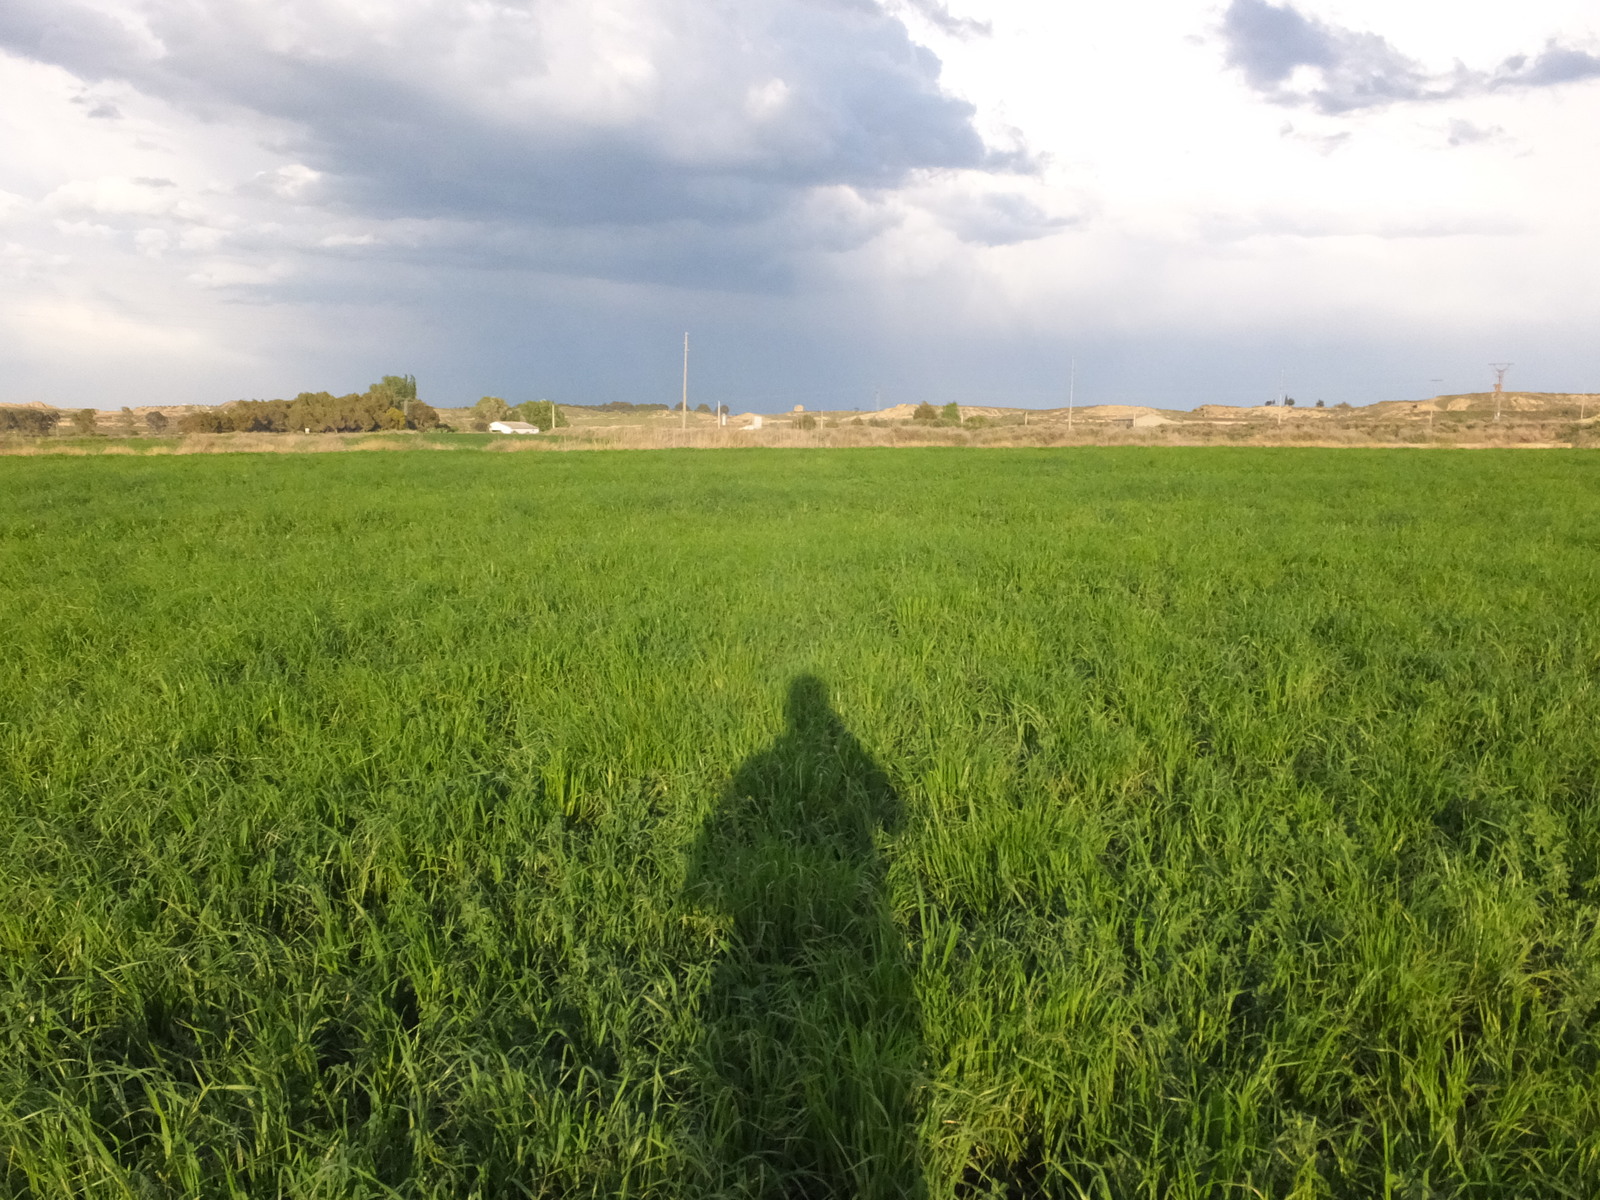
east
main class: Cropland
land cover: Other leguminous and mixtures for fodder
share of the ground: > 75 %
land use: Agriculture (excluding fallow land and kitchen gardens)
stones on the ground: < 10 %
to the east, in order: Other leguminous and mixtures for fodder; Grass margins; Ditches and canals; Shruby margins; Other fibre and oleaginous crops; Electric lines; Shruby margins; Barley; Shruby margins; Tracks; Shruby margins; Temporary grasslands
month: April
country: ES
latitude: 41.7609
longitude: -0.3267
